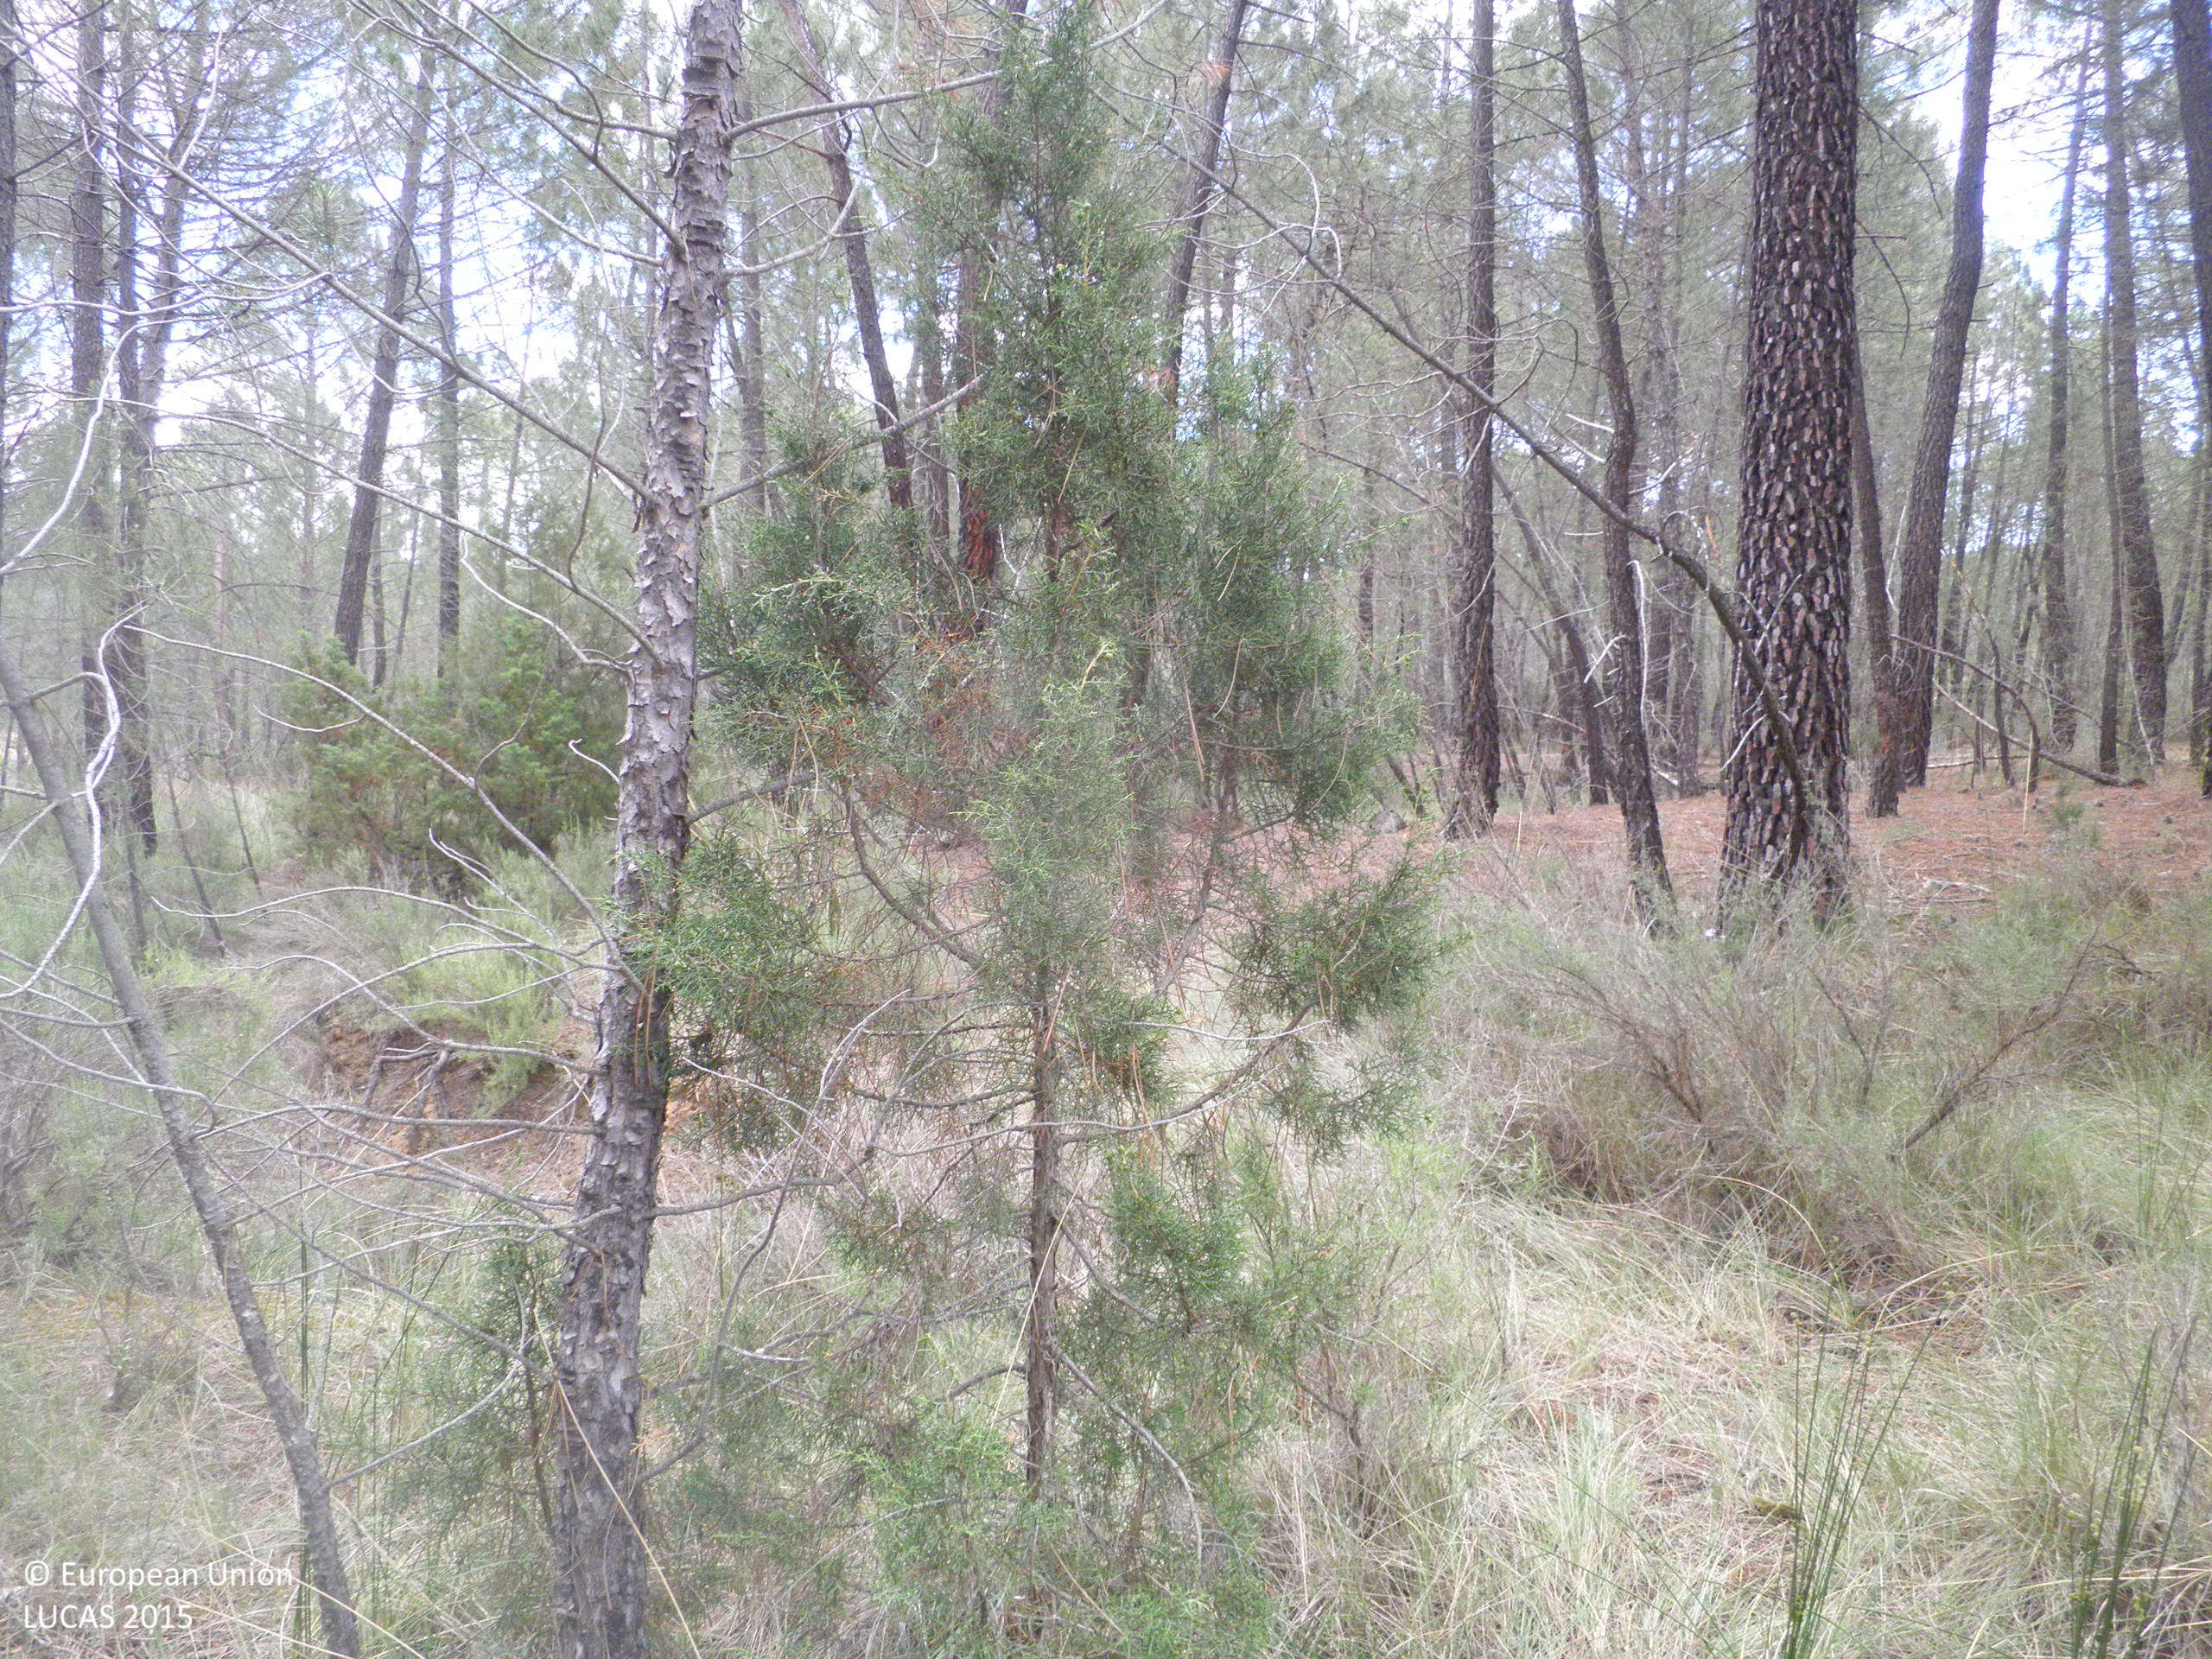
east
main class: Woodland
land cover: Pine dominated coniferous woodland
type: coniferous forest of the mediterranean region
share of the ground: 50 - 75 %
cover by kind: coniferous forest trees 60 %, herbaceous plants 20 %, shrubs 10 %, consolidated bare surface 10 %
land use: Semi-natural and natural areas not in use
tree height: > 5 m
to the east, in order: Pine dominated coniferous woodland; Grassland without tree/shrub cover; Tracks; Grassland without tree/shrub cover; Pine dominated coniferous woodland; Tracks; Pine dominated coniferous woodland
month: June
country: ES
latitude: 39.7898
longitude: -1.6510
